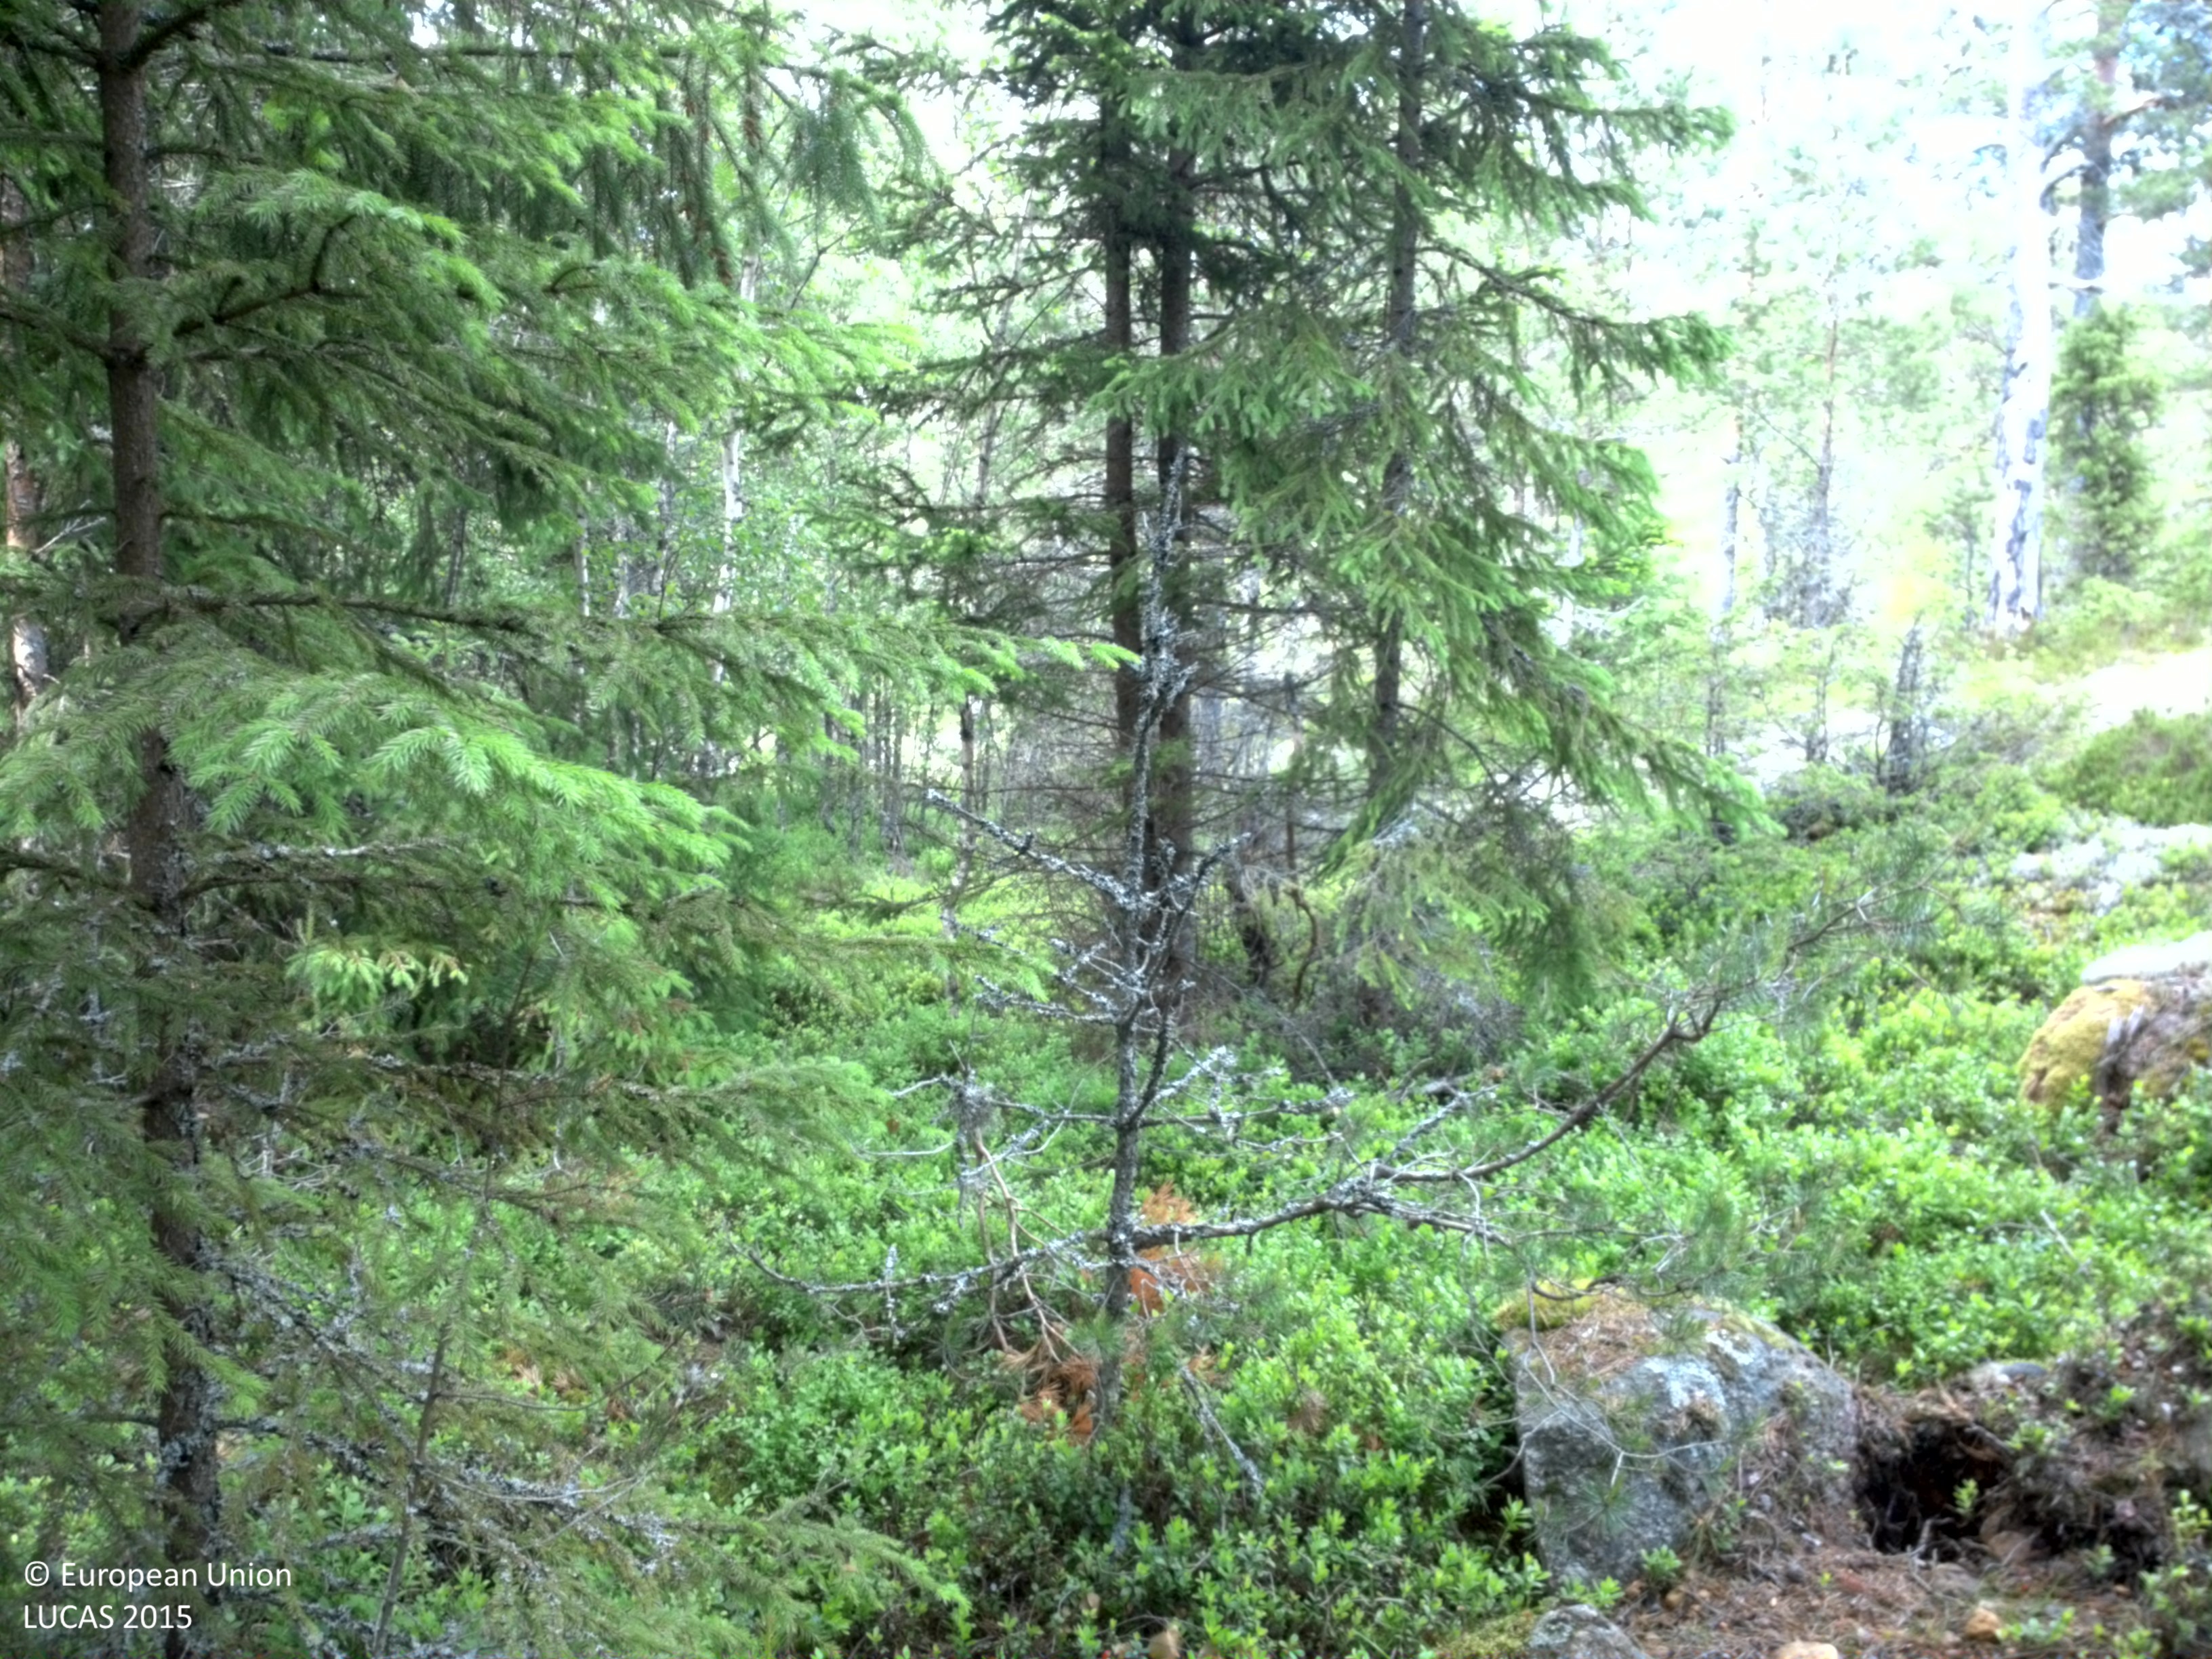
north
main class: Woodland
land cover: Pine dominated mixed woodland
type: boreal forest
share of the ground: 50 - 75 %
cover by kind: coniferous forest trees 40 %, herbaceous plants 35 %, broadleaved forest trees 15 %, lichens and mosses 10 %
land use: Forestry
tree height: > 5 m
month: June
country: SE
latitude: 58.6056
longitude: 15.6564
